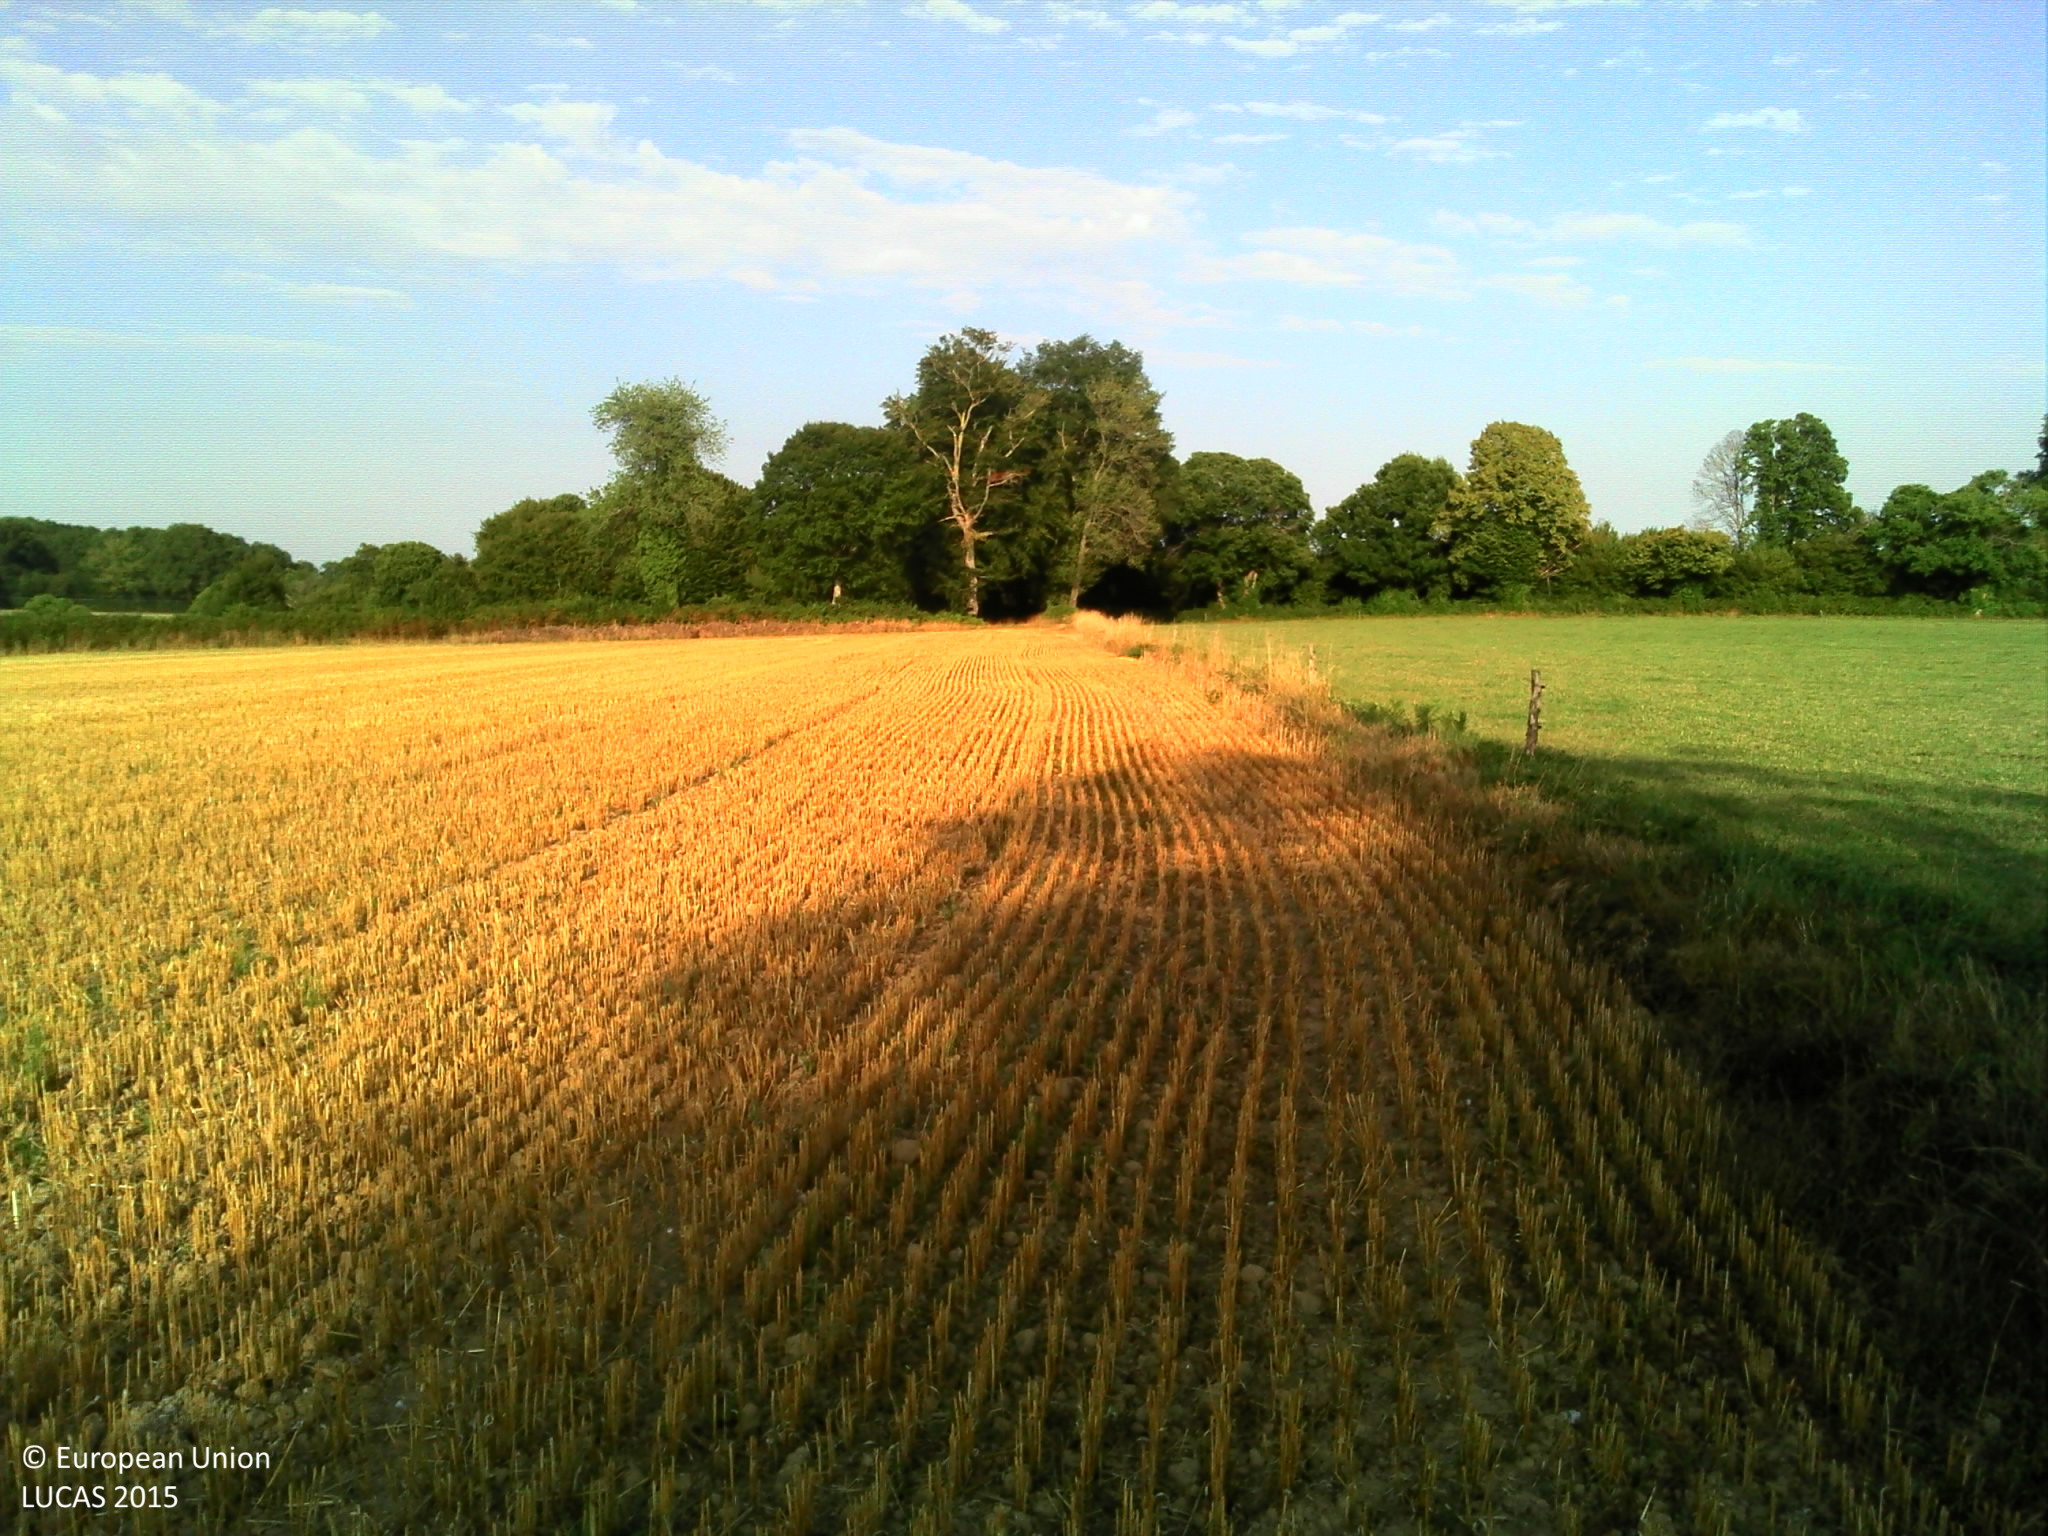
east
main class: Cropland
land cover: Oats
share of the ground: > 75 %
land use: Agriculture (excluding fallow land and kitchen gardens)
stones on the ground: 10 - 25 %
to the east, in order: Oats; Broadleaved woodland; Fences; Tracks; Broadleaved woodland; Maize
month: August
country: FR
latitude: 46.3939
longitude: 2.2301
